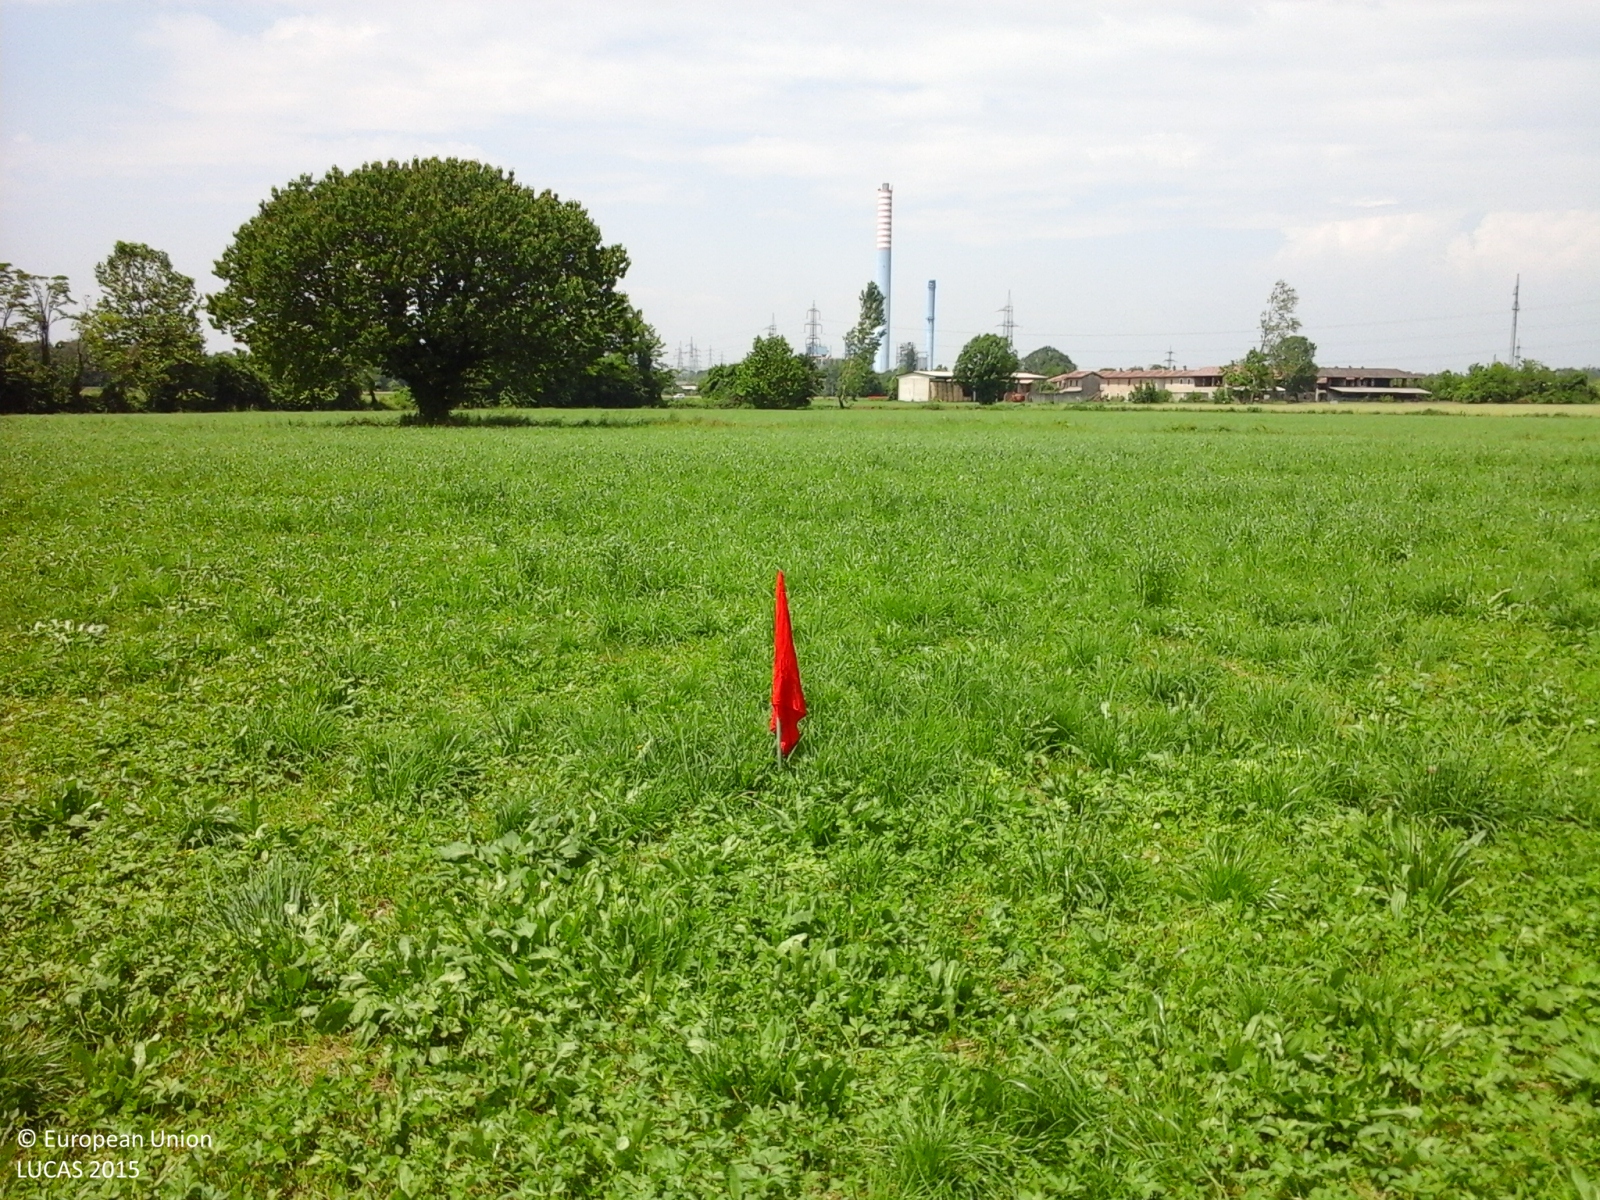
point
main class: Grassland
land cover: Spontaneously vegetated surfaces
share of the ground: > 75 %
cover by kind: herbaceous plants 100 %
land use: Agriculture (excluding fallow land and kitchen gardens)
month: May
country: IT
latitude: 45.5033
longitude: 9.5273
